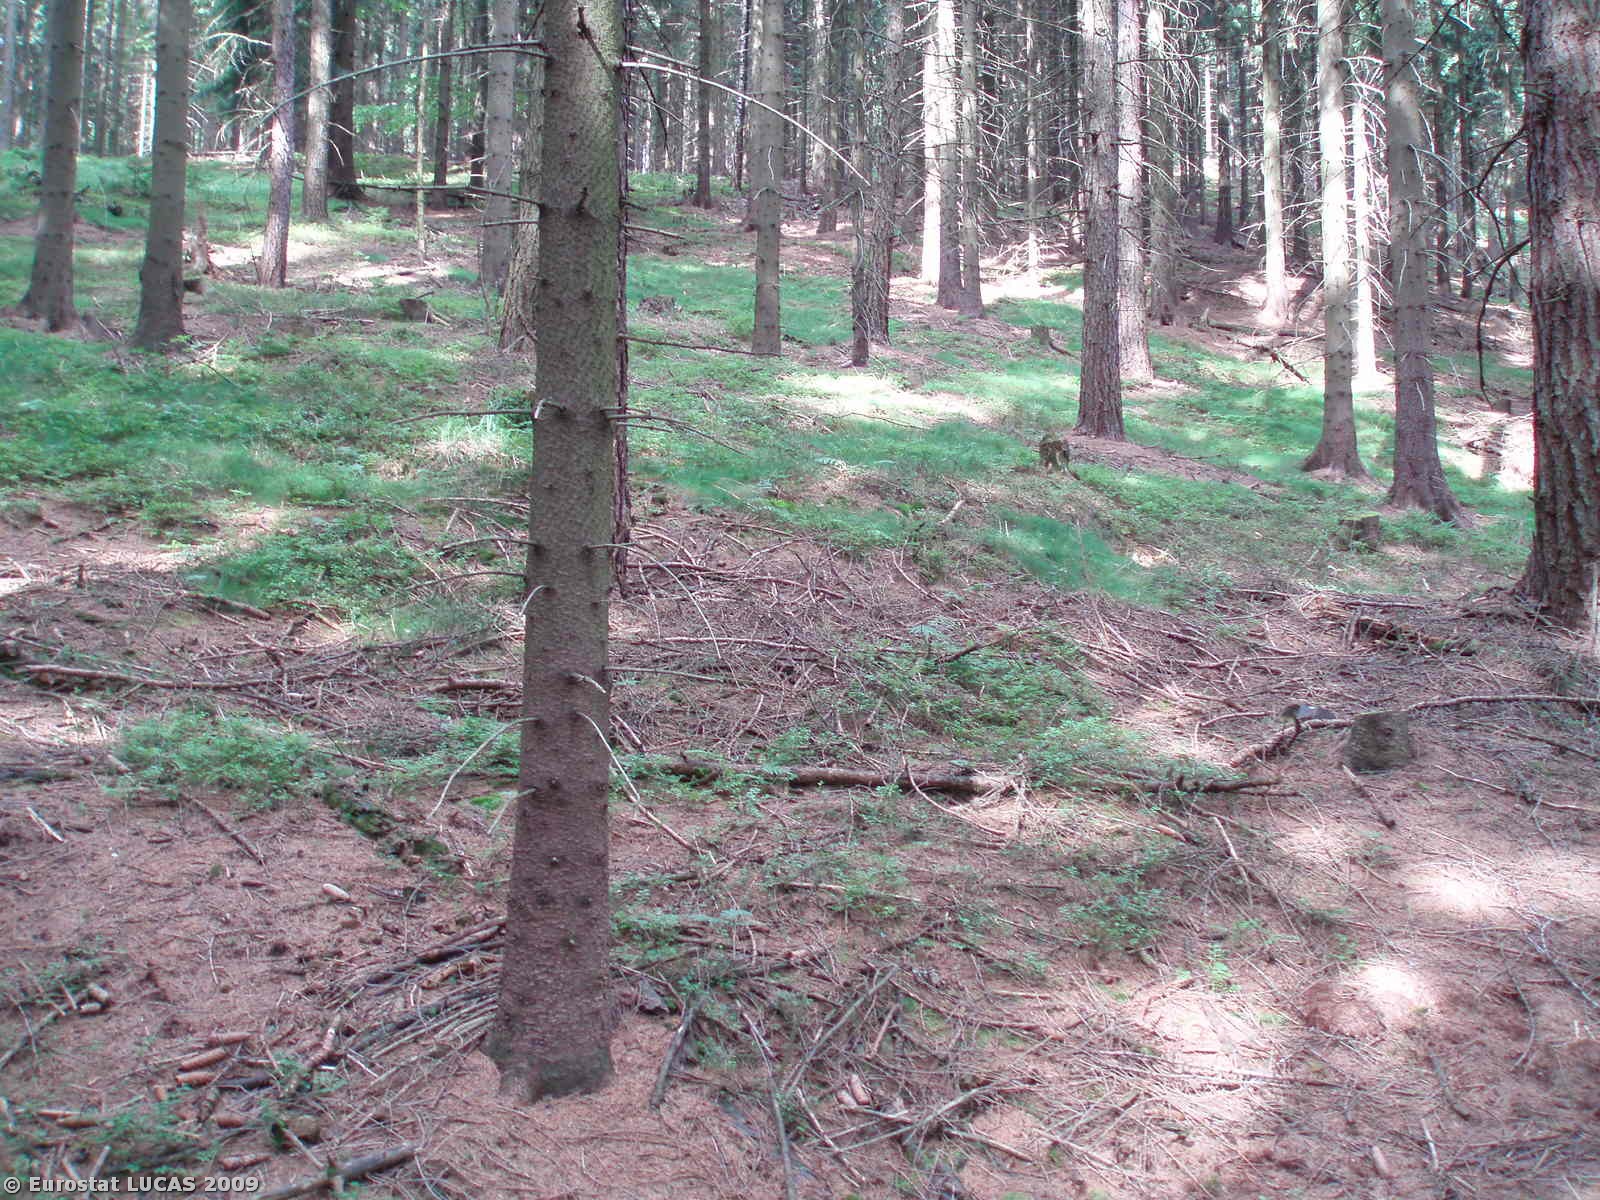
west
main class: Woodland
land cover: Coniferous woodland
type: hemiboreal forest and nemoral coniferous forest and mixed broadleaved-coniferous forest
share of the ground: > 75 %
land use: Forestry
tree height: > 5 m
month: July
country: CZ
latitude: 50.7601
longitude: 14.9788
